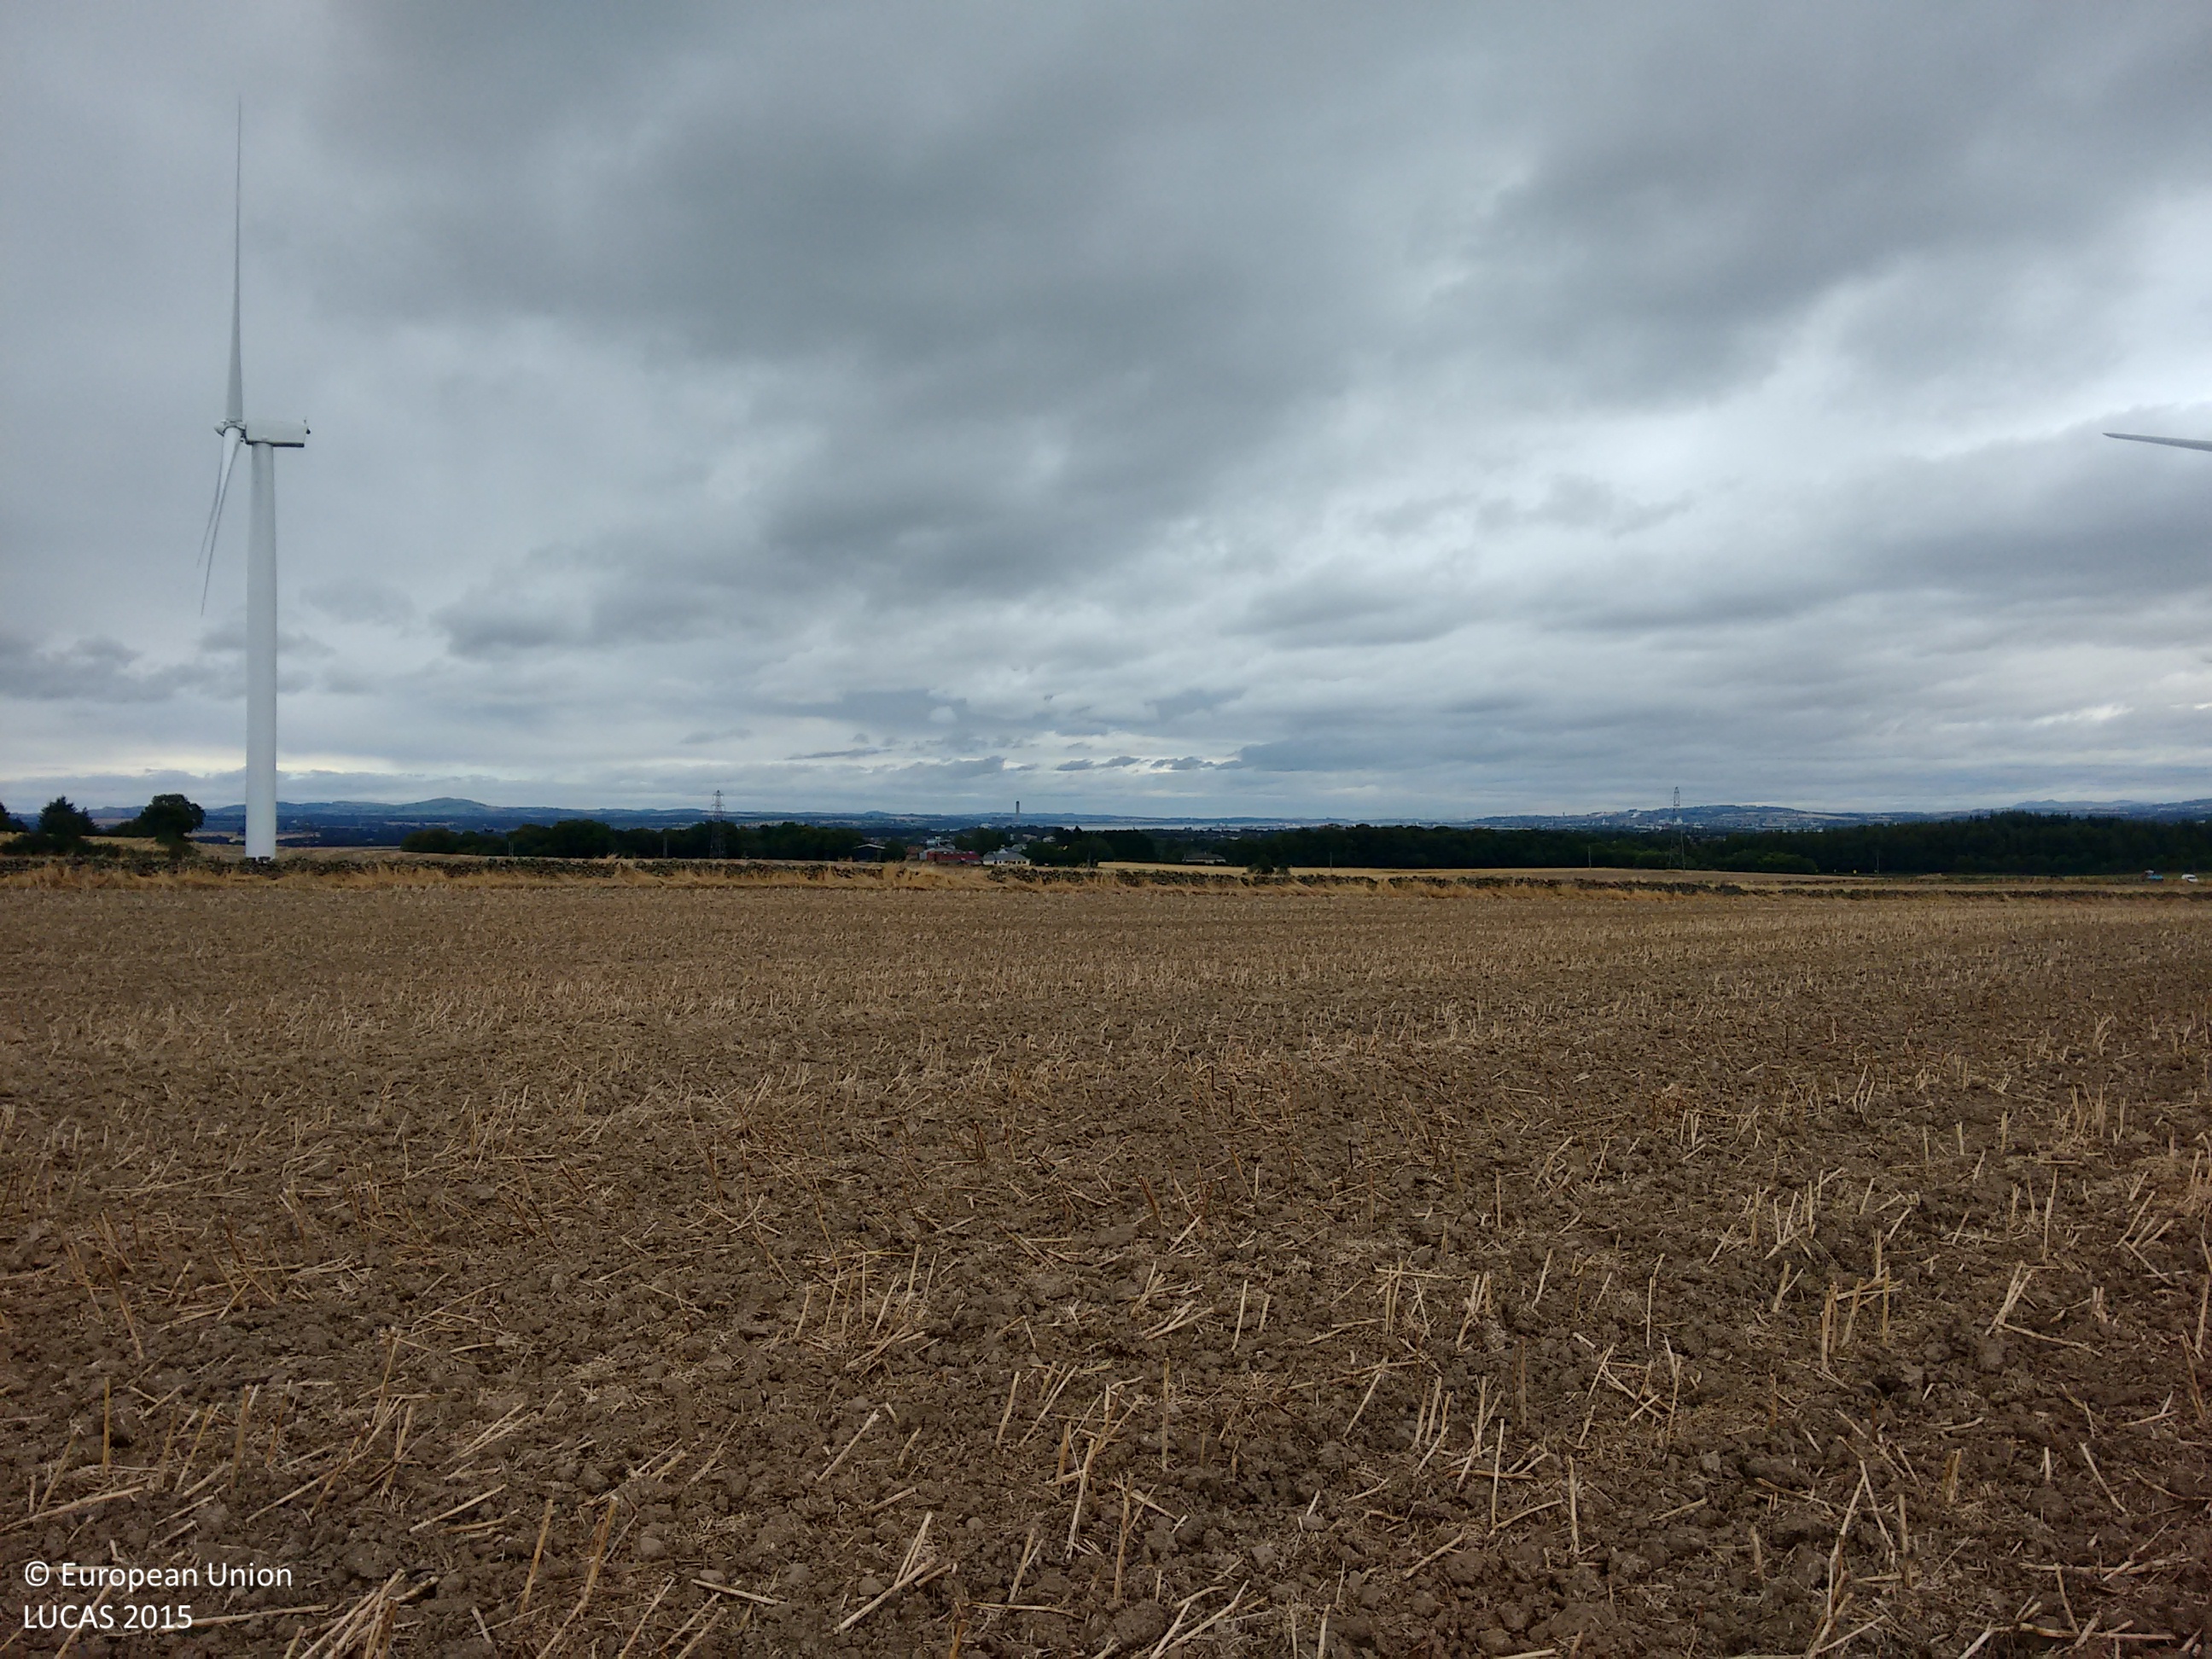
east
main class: Cropland
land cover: Rape and turnip rape
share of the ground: < 10 %
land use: Agriculture (excluding fallow land and kitchen gardens)
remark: Harvested field
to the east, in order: Rape and turnip rape; Dry stone walls; Rape and turnip rape
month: September
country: GB
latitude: 56.0326
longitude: -3.8699
